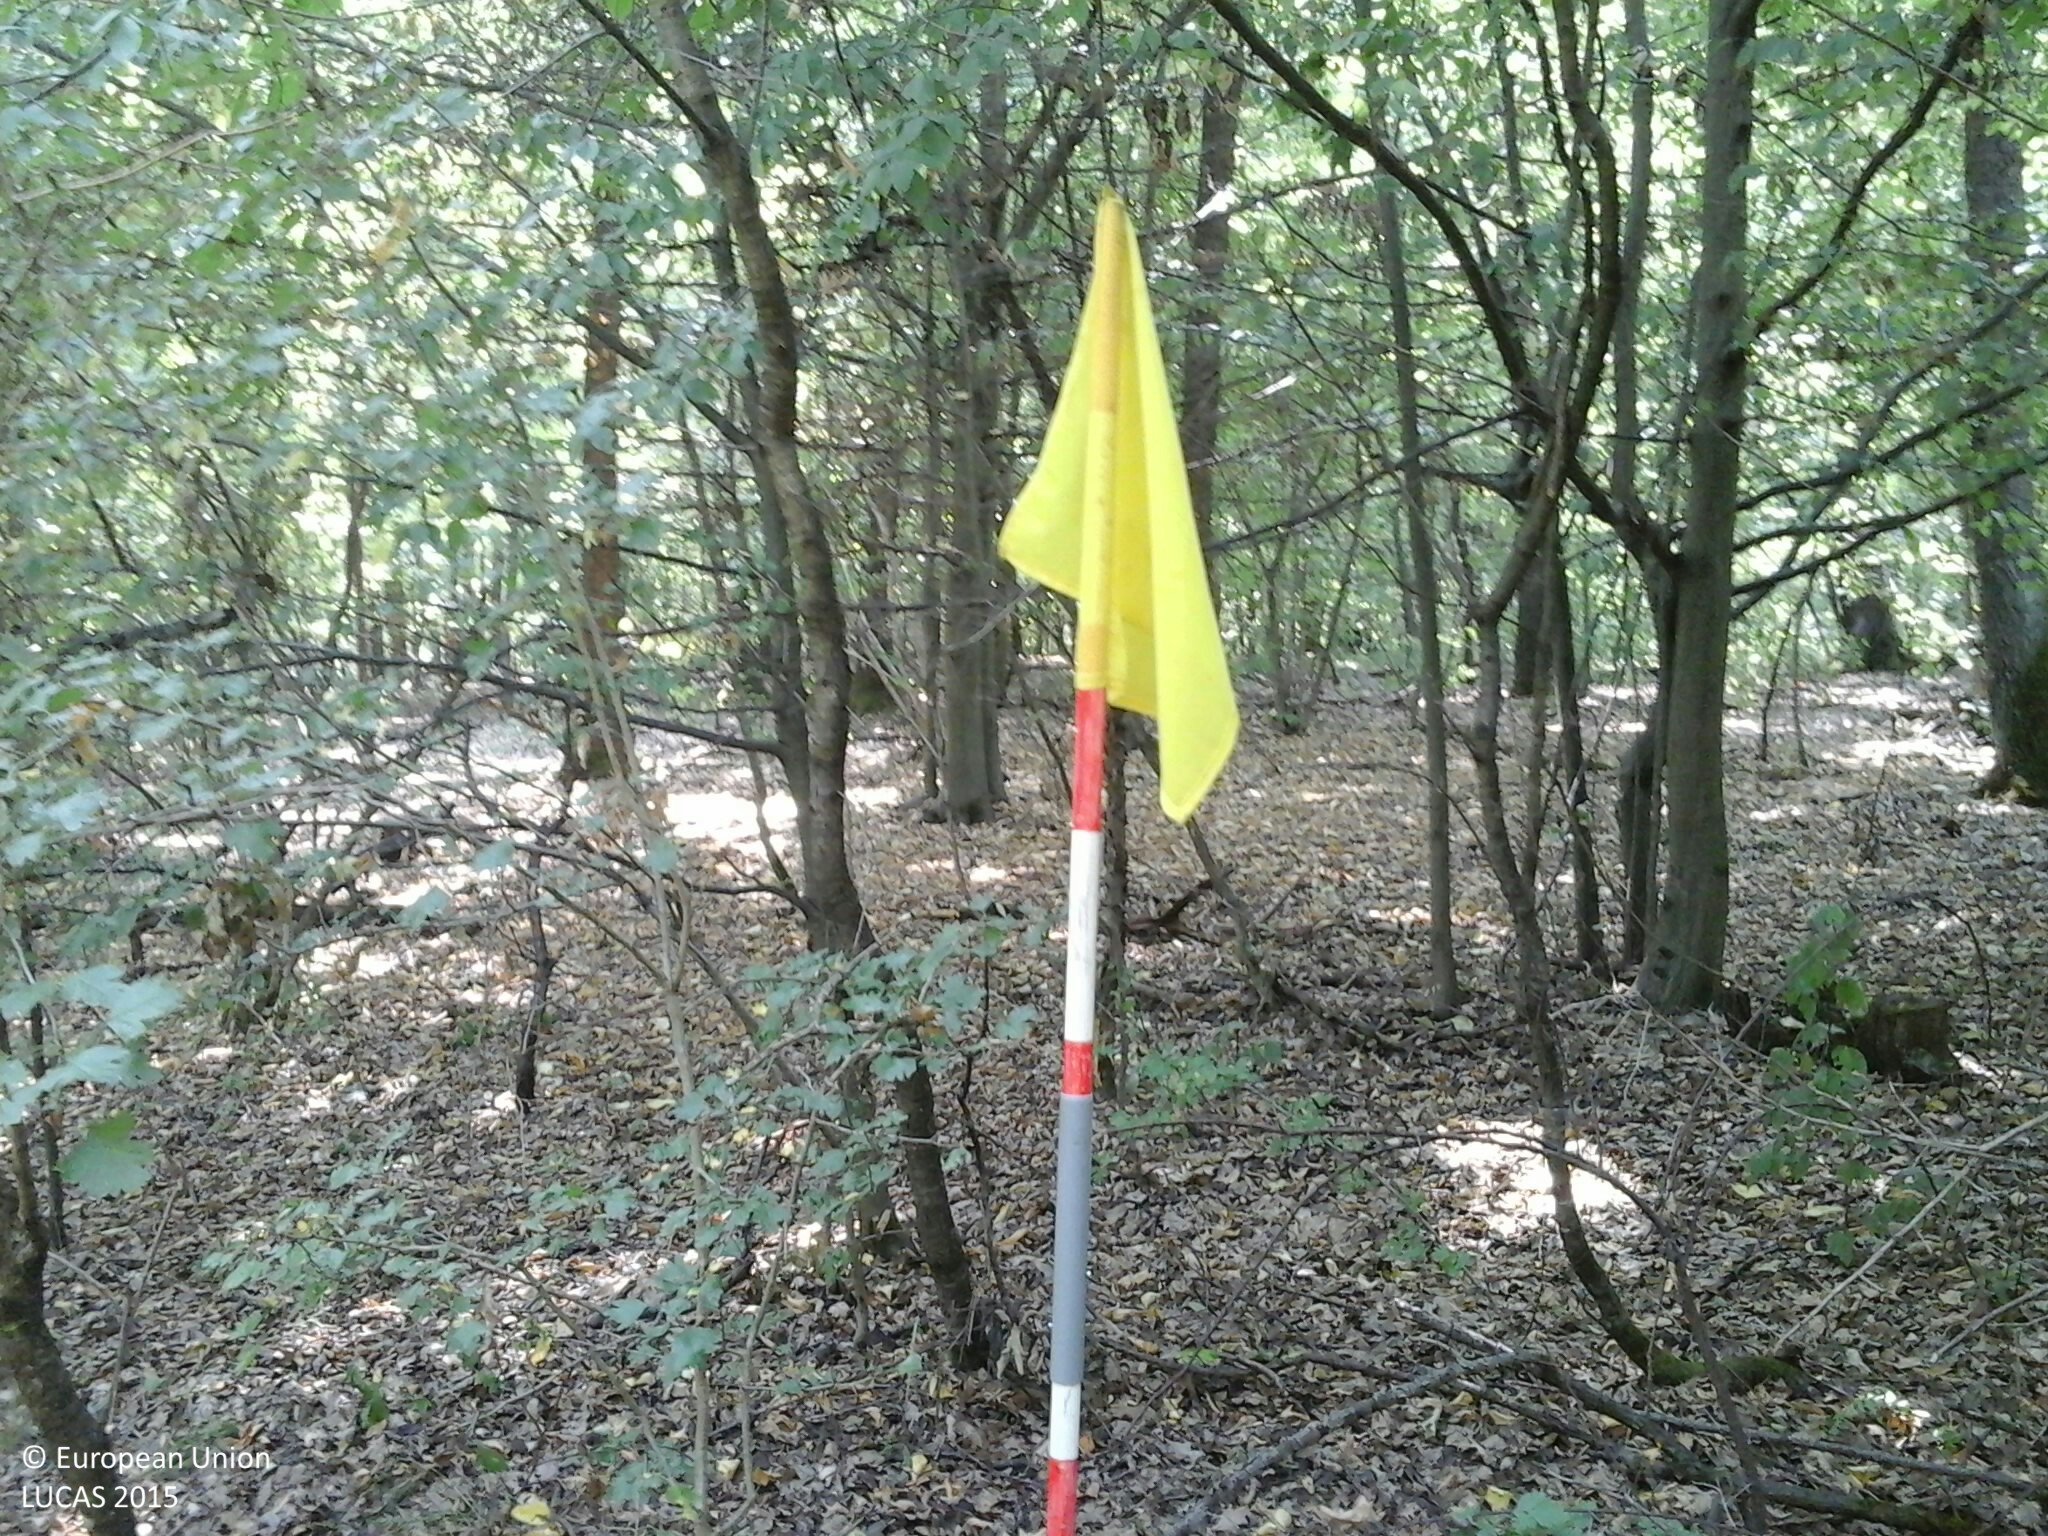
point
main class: Woodland
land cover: Broadleaved woodland
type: mesophytic deciduous forest
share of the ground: > 75 %
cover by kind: broadleaved forest trees 100 %
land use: Forestry
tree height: > 5 m
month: August
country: HU
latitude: 48.4453
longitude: 20.5121
